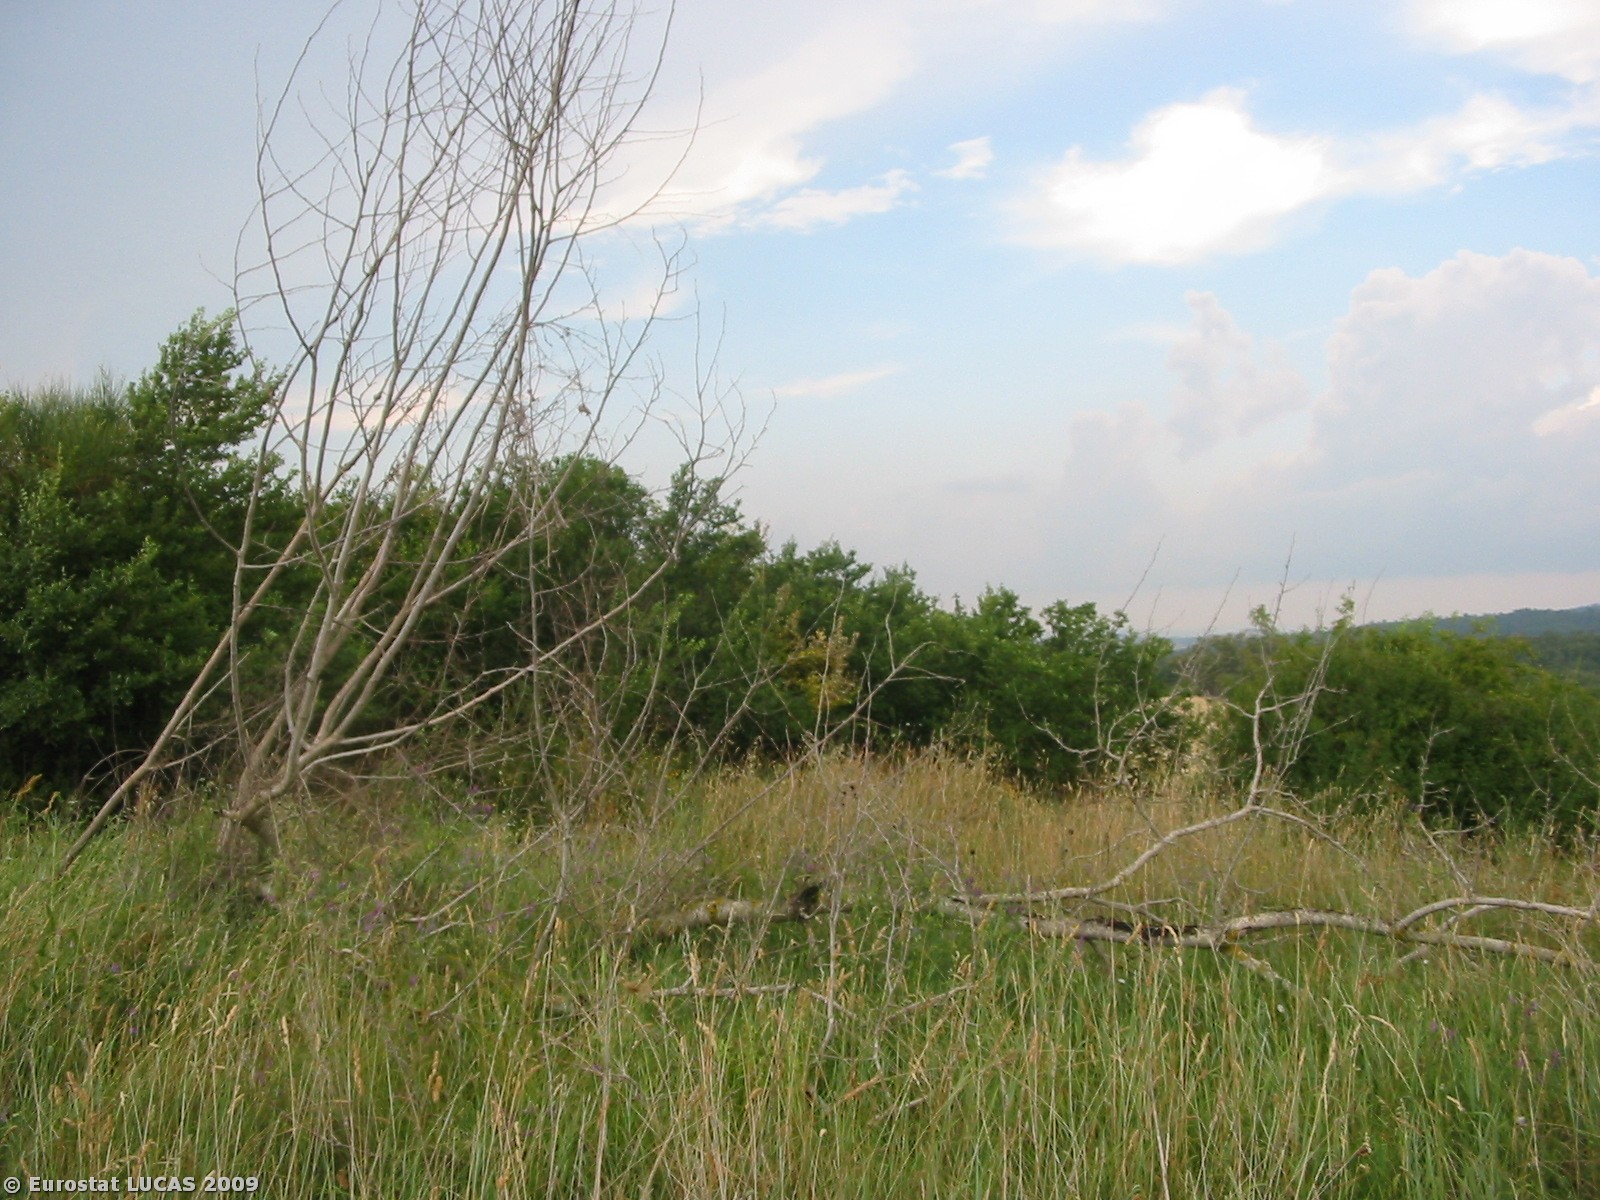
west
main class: Cropland
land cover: Durum wheat
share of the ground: > 75 %
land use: Agriculture (excluding fallow land and kitchen gardens)
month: June
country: IT
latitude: 43.1097
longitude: 11.6785
